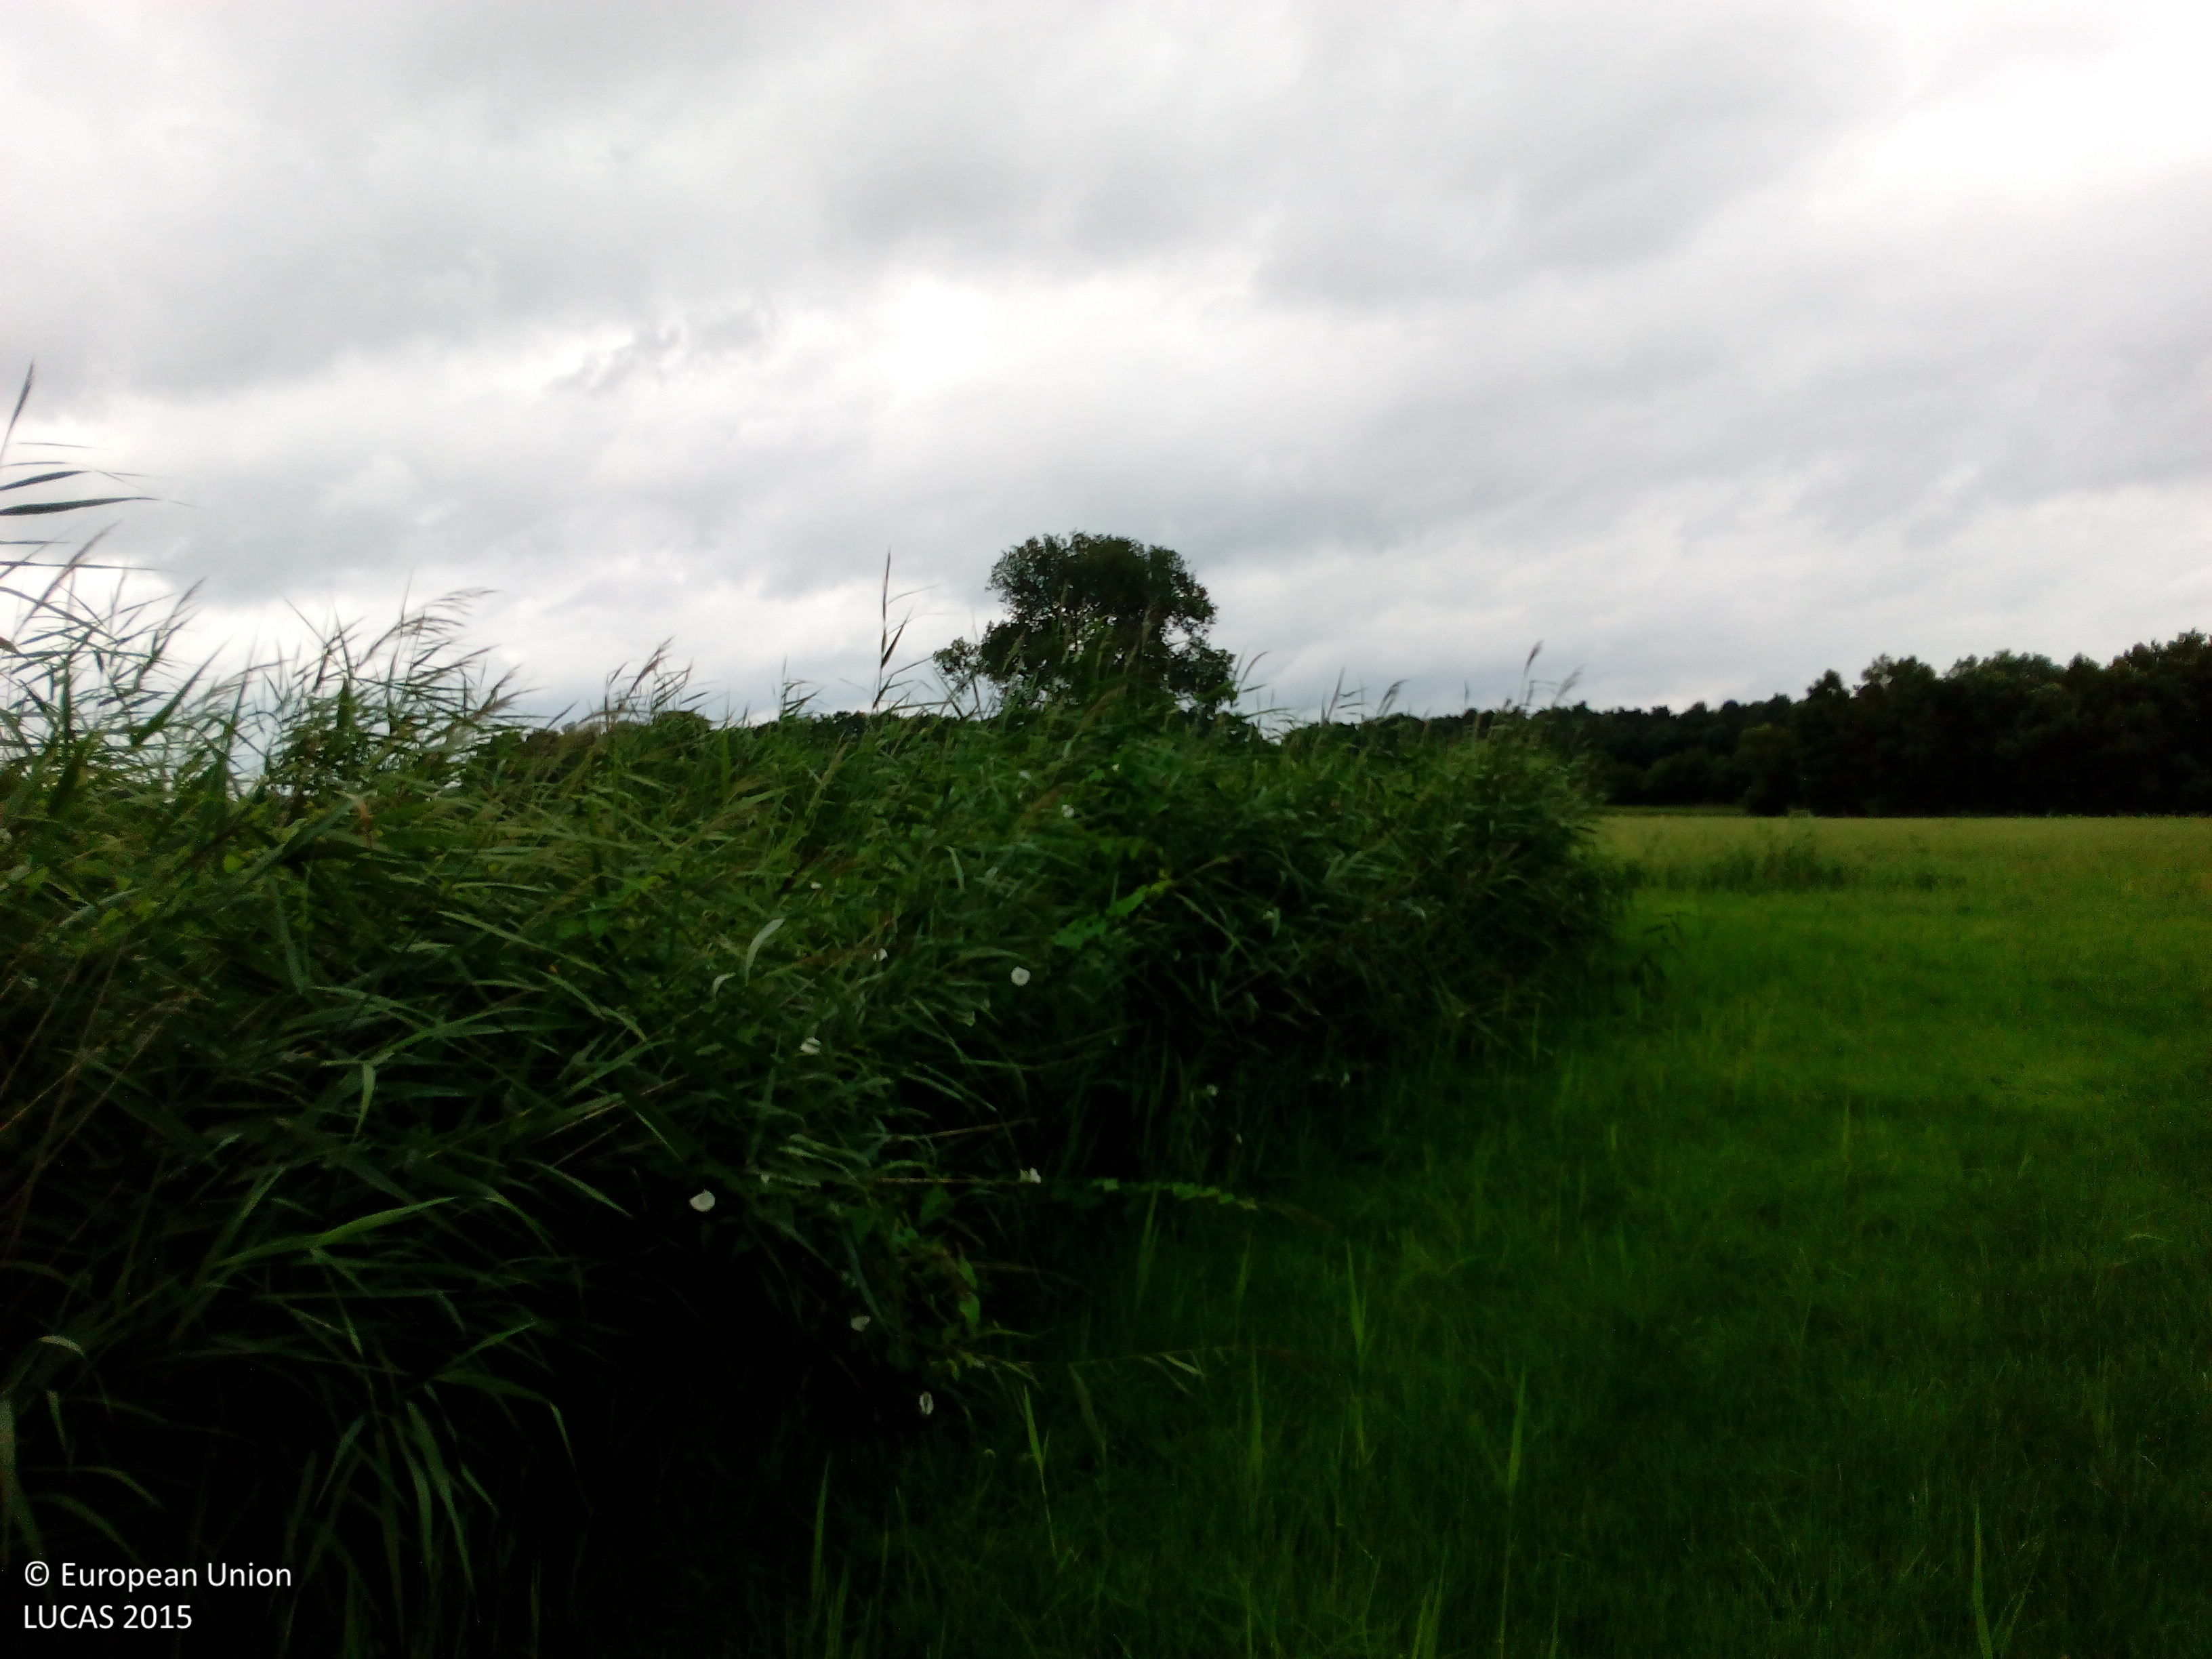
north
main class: Grassland
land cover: Grassland without tree/shrub cover
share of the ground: > 75 %
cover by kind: herbaceous plants 100 %
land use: Agriculture (excluding fallow land and kitchen gardens)
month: July
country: DE
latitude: 52.3240
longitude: 7.9610
